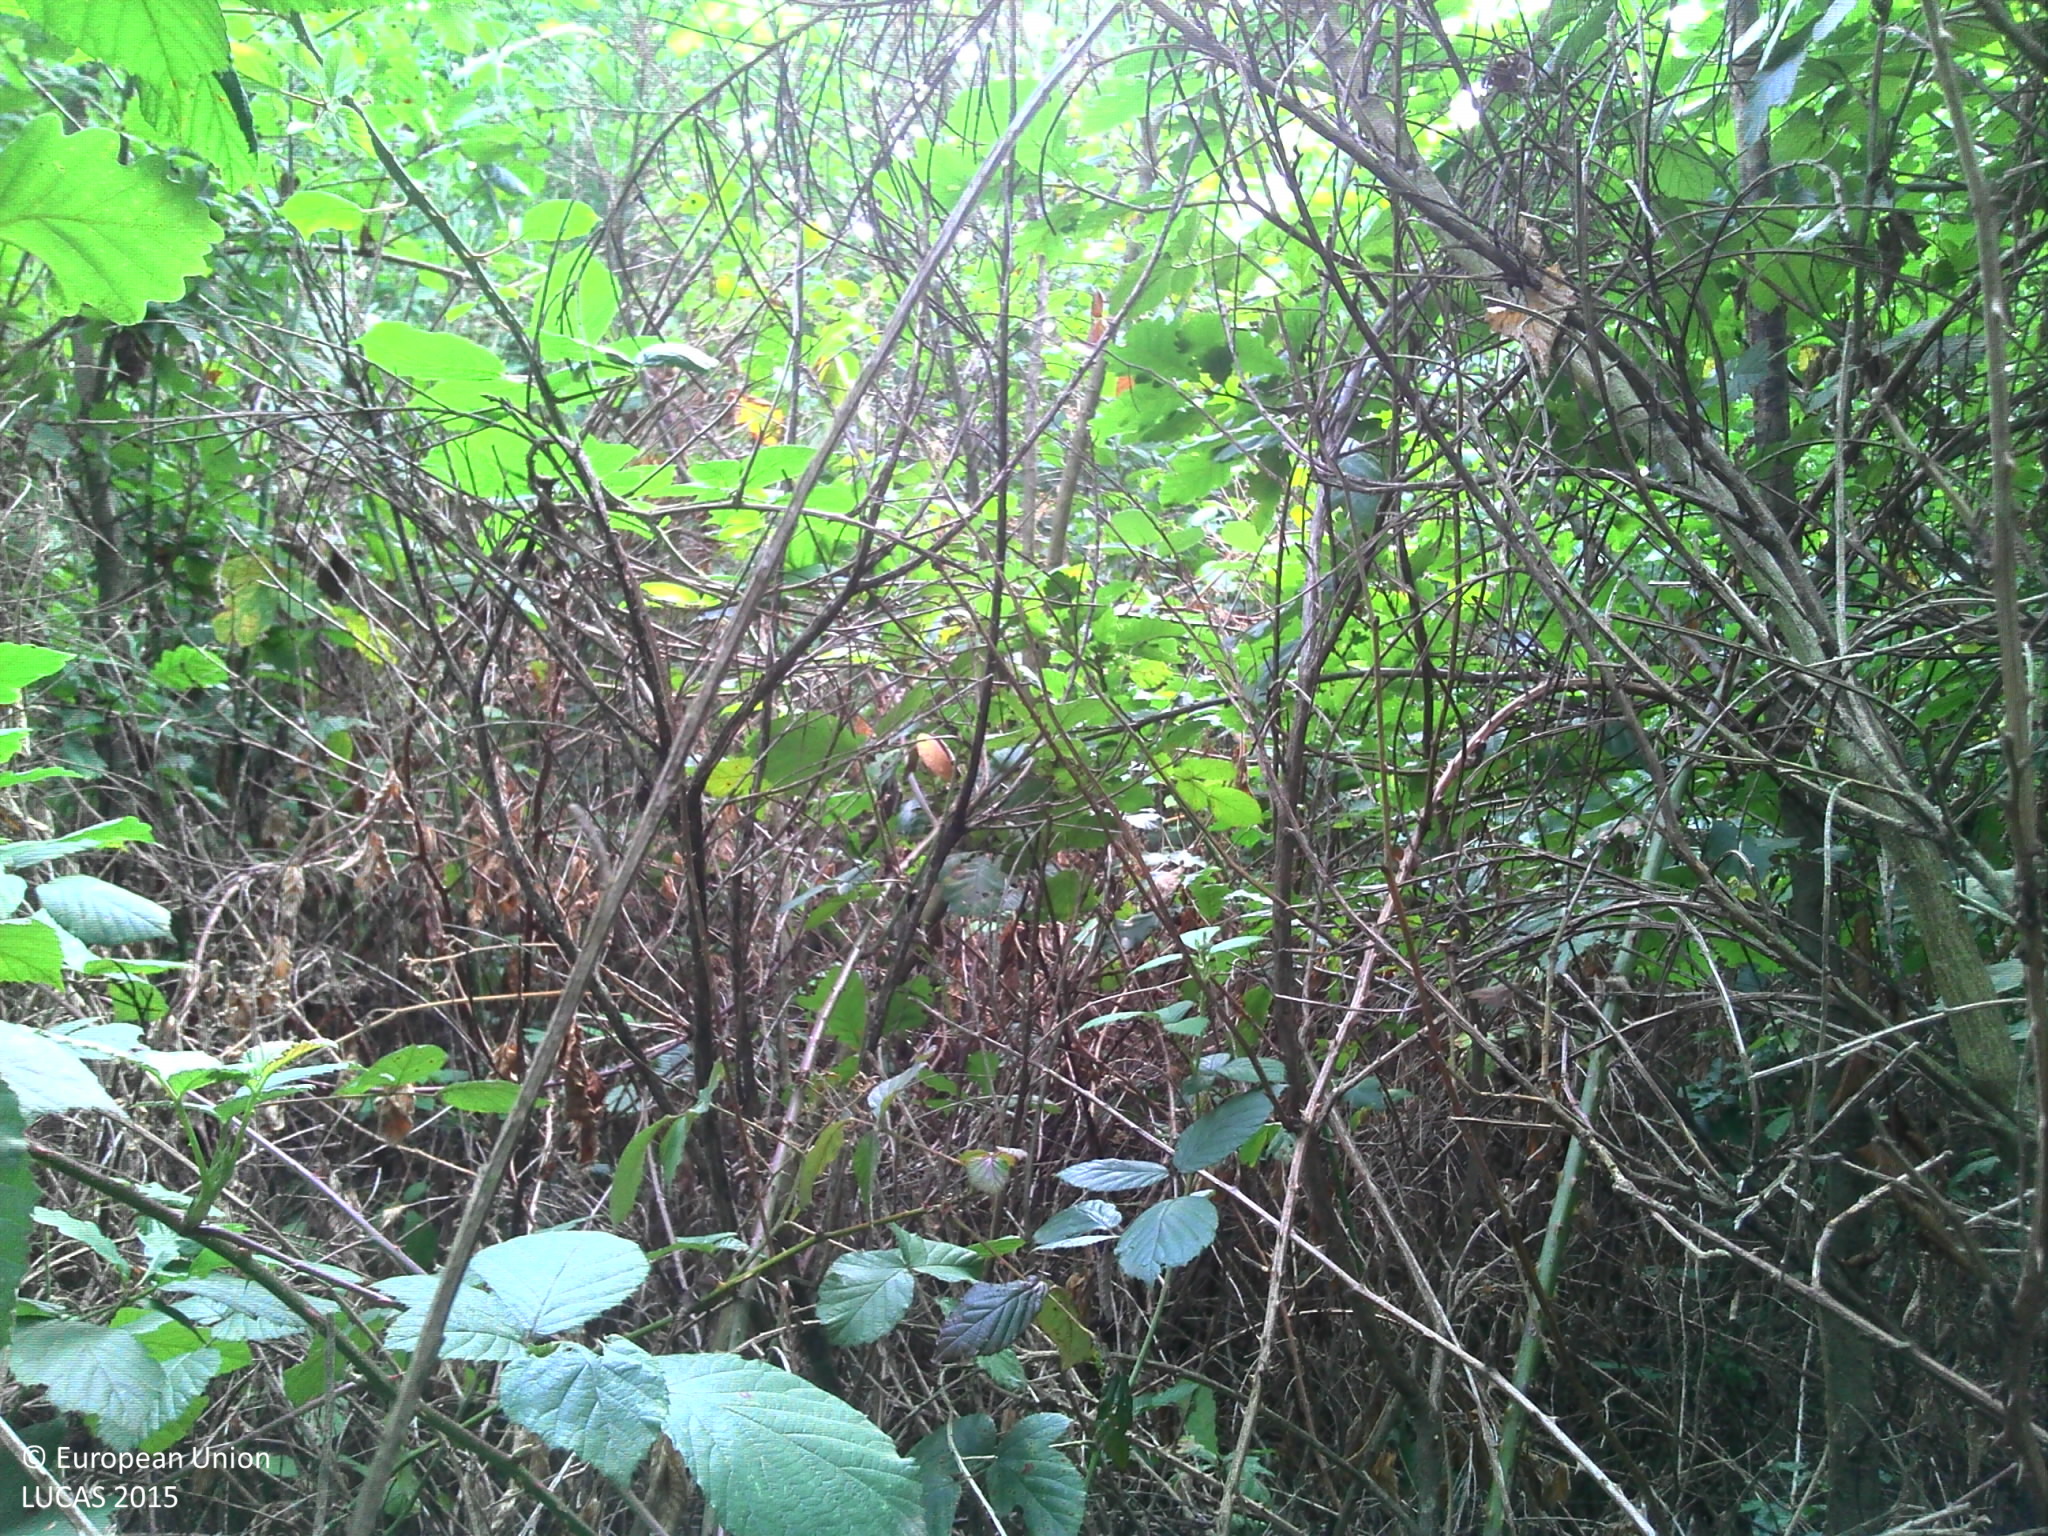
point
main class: Woodland
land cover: Broadleaved woodland
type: mesophytic deciduous forest
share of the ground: > 75 %
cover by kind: broadleaved forest trees 80 %, shrubs 20 %
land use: Forestry
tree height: < 5 m
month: September
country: FR
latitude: 47.1429
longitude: 4.3955
